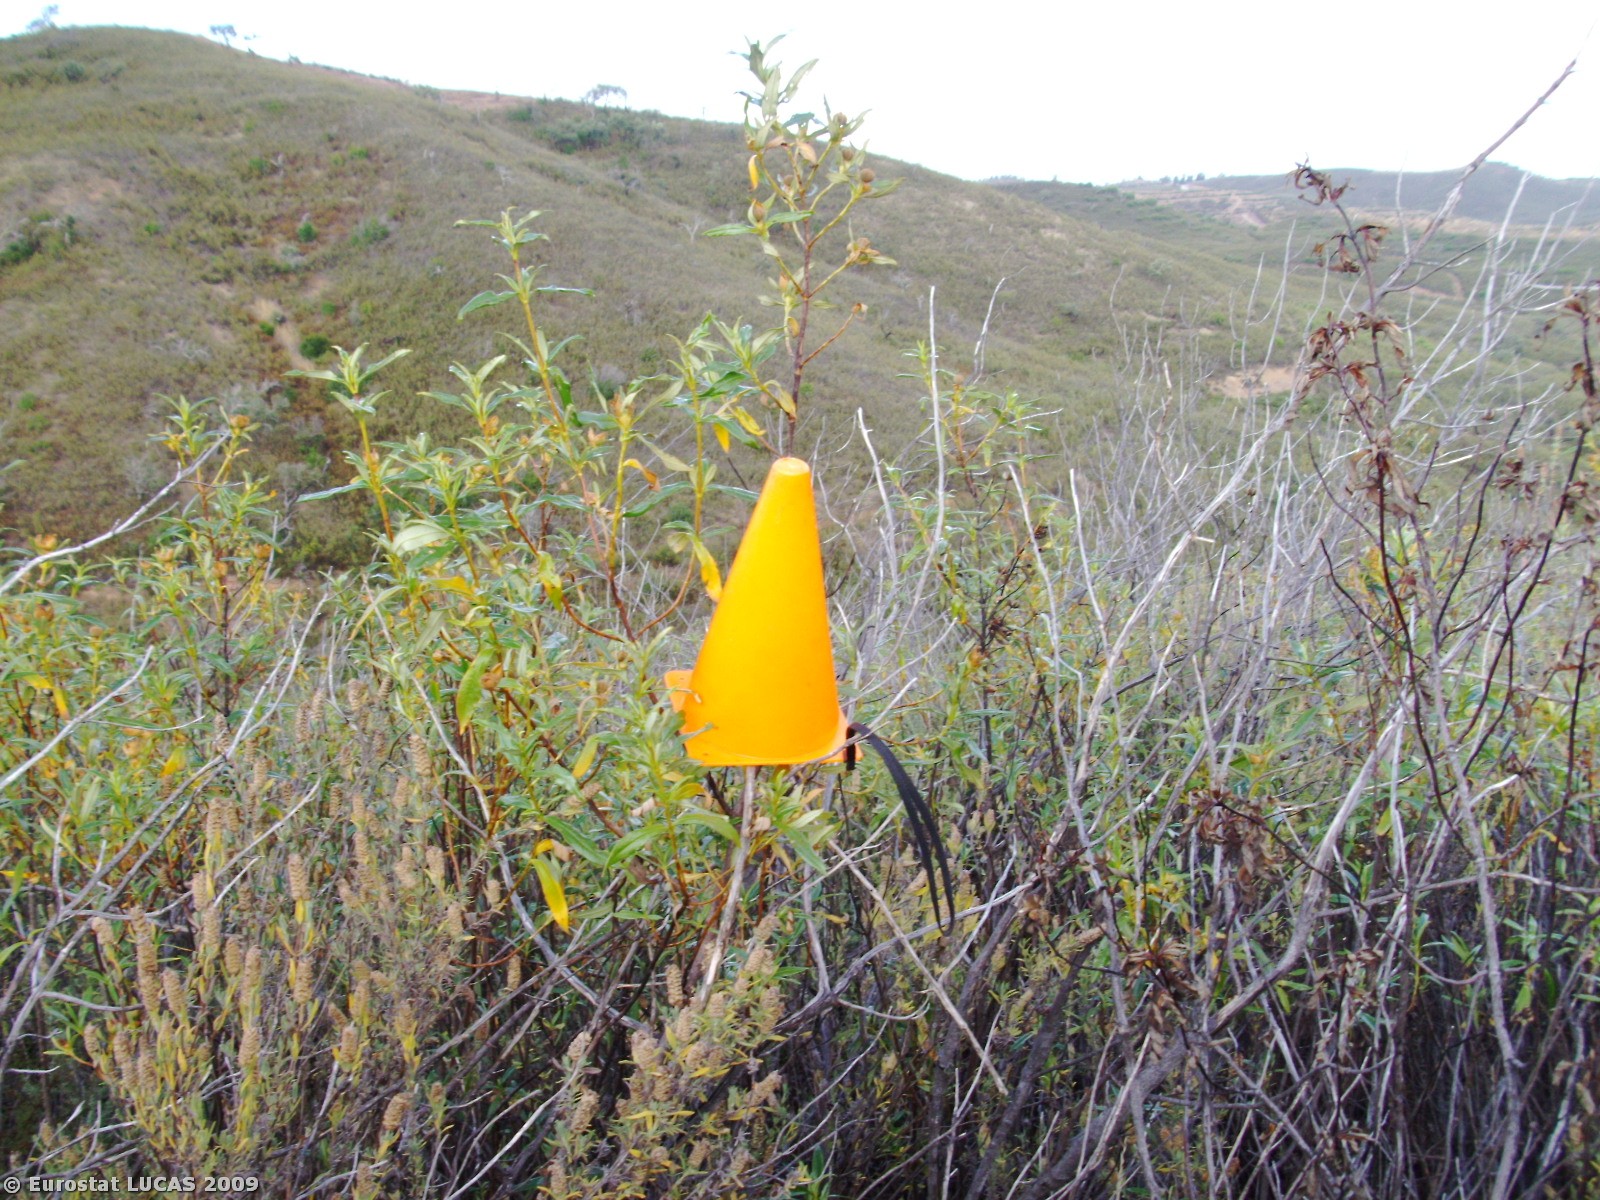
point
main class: Shrubland
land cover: Shrubland without tree cover
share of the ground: > 75 %
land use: Unused
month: June
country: PT
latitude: 37.2182
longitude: -8.7509
